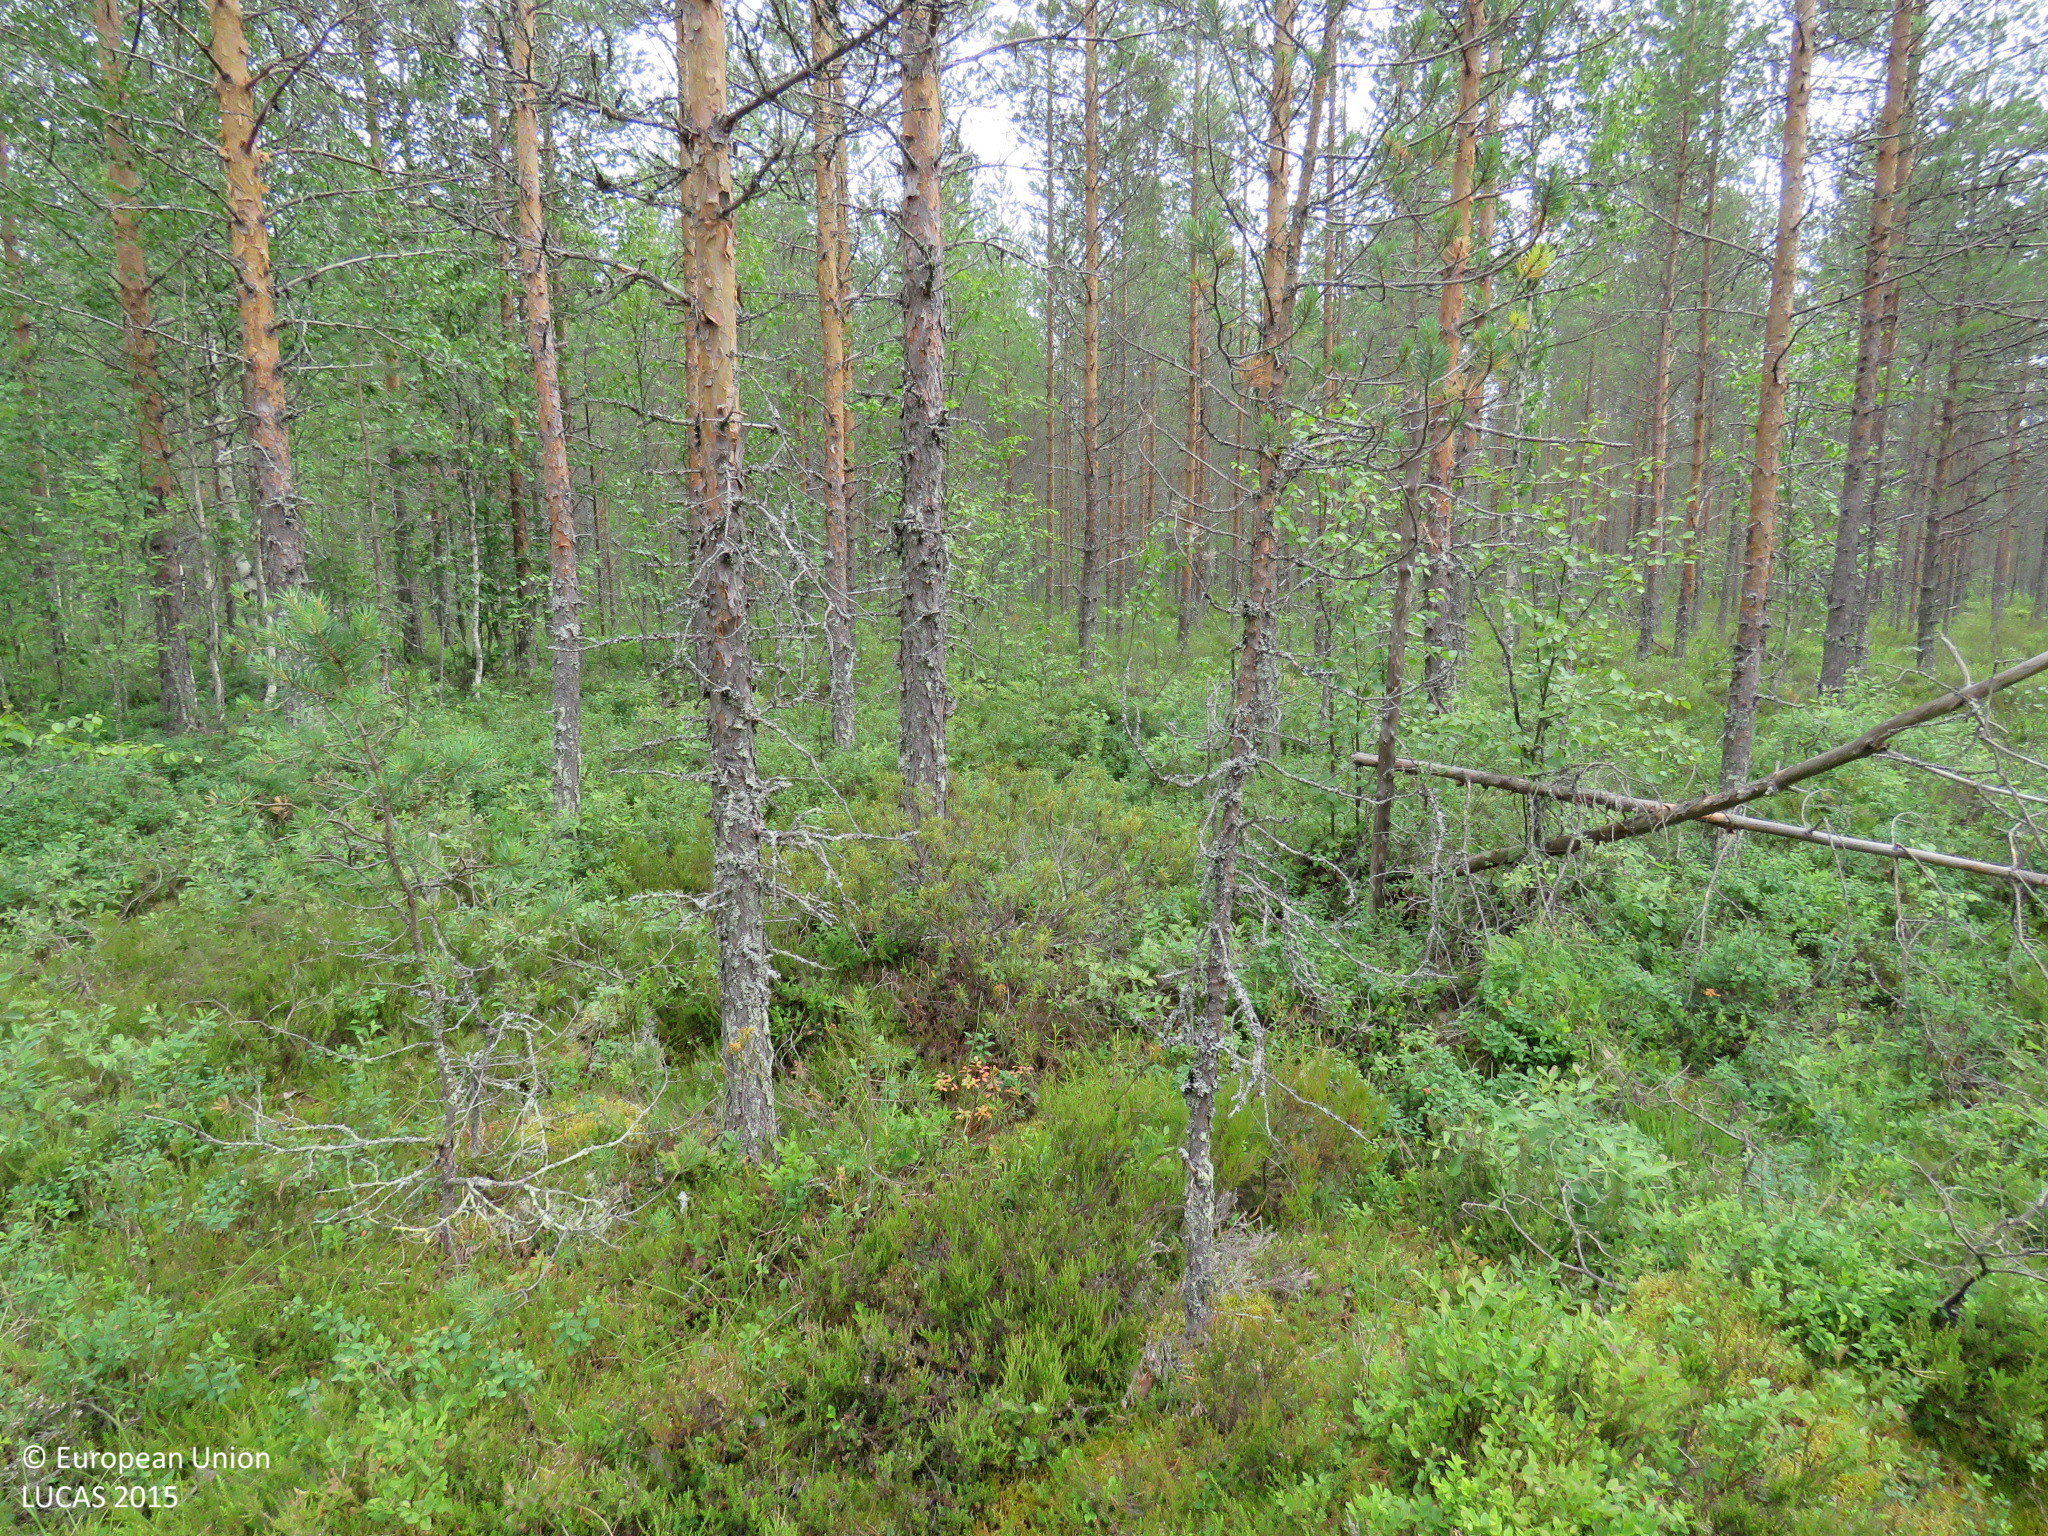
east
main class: Woodland
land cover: Pine dominated coniferous woodland
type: mire and swamp forests
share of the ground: 50 - 75 %
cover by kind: coniferous forest trees 45 %, shrubs 30 %, broadleaved forest trees 10 %, lichens and mosses 10 %, herbaceous plants 5 %
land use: Forestry
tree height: > 5 m
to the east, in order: Pine dominated coniferous woodland; Ditches and canals; Pine dominated coniferous woodland; Ditches and canals; Pine dominated mixed woodland; Ditches and canals; Pine dominated mixed woodland; Ditches and canals; Pine dominated mixed woodland; Ditches and canals; Pine dominated mixed woodland; Ditches and canals; Pine dominated mixed woodland; Pine dominated coniferous woodland; Pine dominated mixed woodland
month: July
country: FI
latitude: 64.6391
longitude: 26.8410
